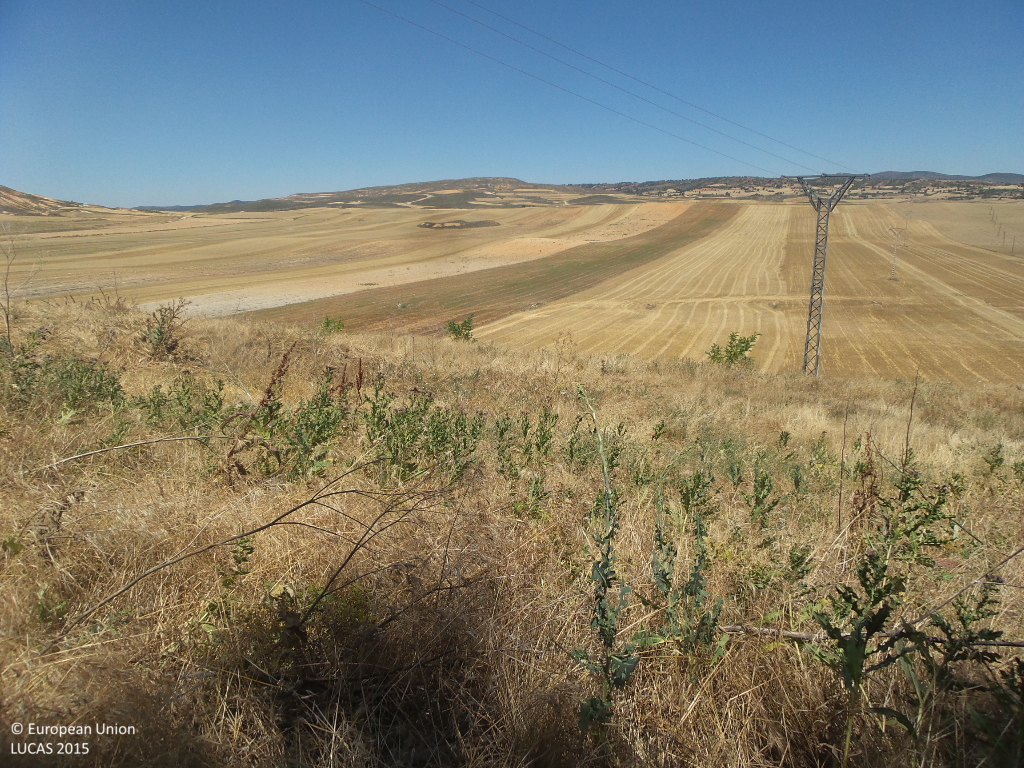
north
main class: Grassland
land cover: Grassland with sparse tree/shrub cover
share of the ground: > 75 %
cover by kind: herbaceous plants 95 %, broadleaved forest trees 5 %
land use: Semi-natural and natural areas not in use
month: July
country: ES
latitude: 41.4175
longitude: -2.0782
